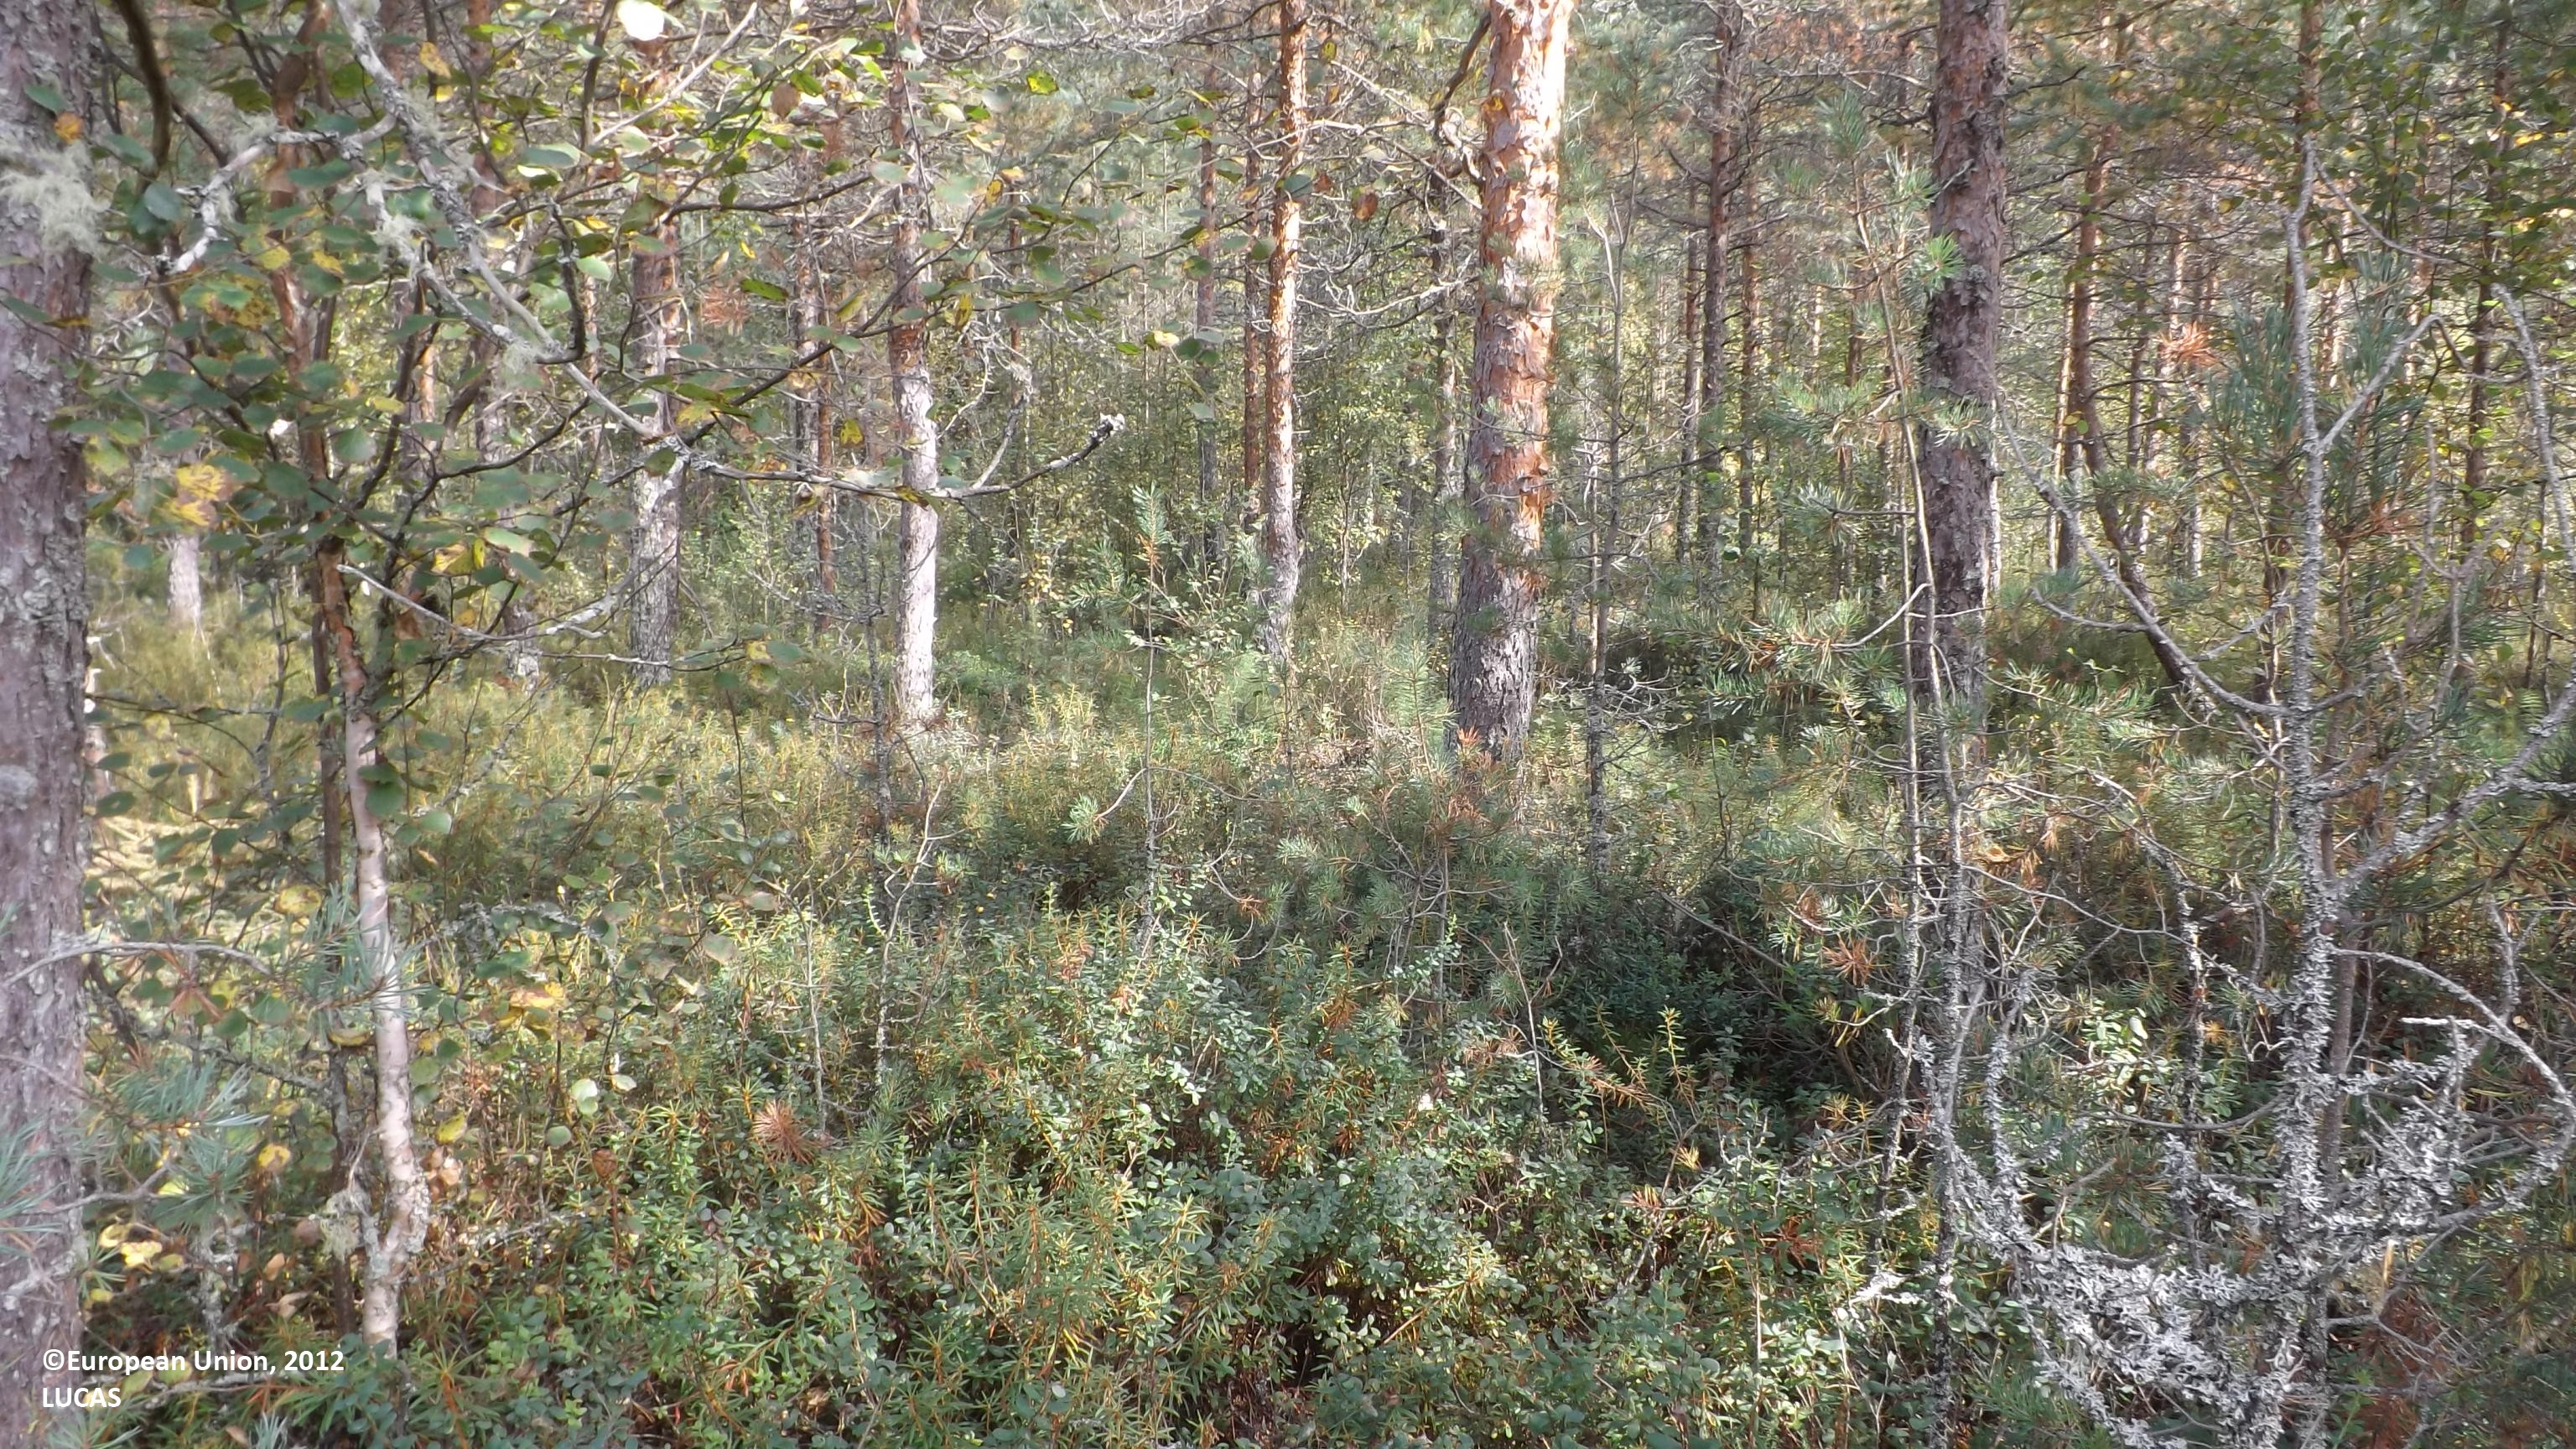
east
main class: Woodland
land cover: Pine dominated coniferous woodland
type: mire and swamp forests
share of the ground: 50 - 75 %
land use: Forestry
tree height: < 5 m
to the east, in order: Pine dominated coniferous woodland; Ditches and canals; Pine dominated coniferous woodland; Ditches and canals; Pine dominated mixed woodland; Spruce dominated mixed woodland; Other mixed woodland; Ditches and canals; Other bare soil; Abandoned hedges; Ditches and canals; Other bare soil; Ditches and canals; Broadleaved woodland
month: August
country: FI
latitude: 63.8935
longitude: 23.6876
